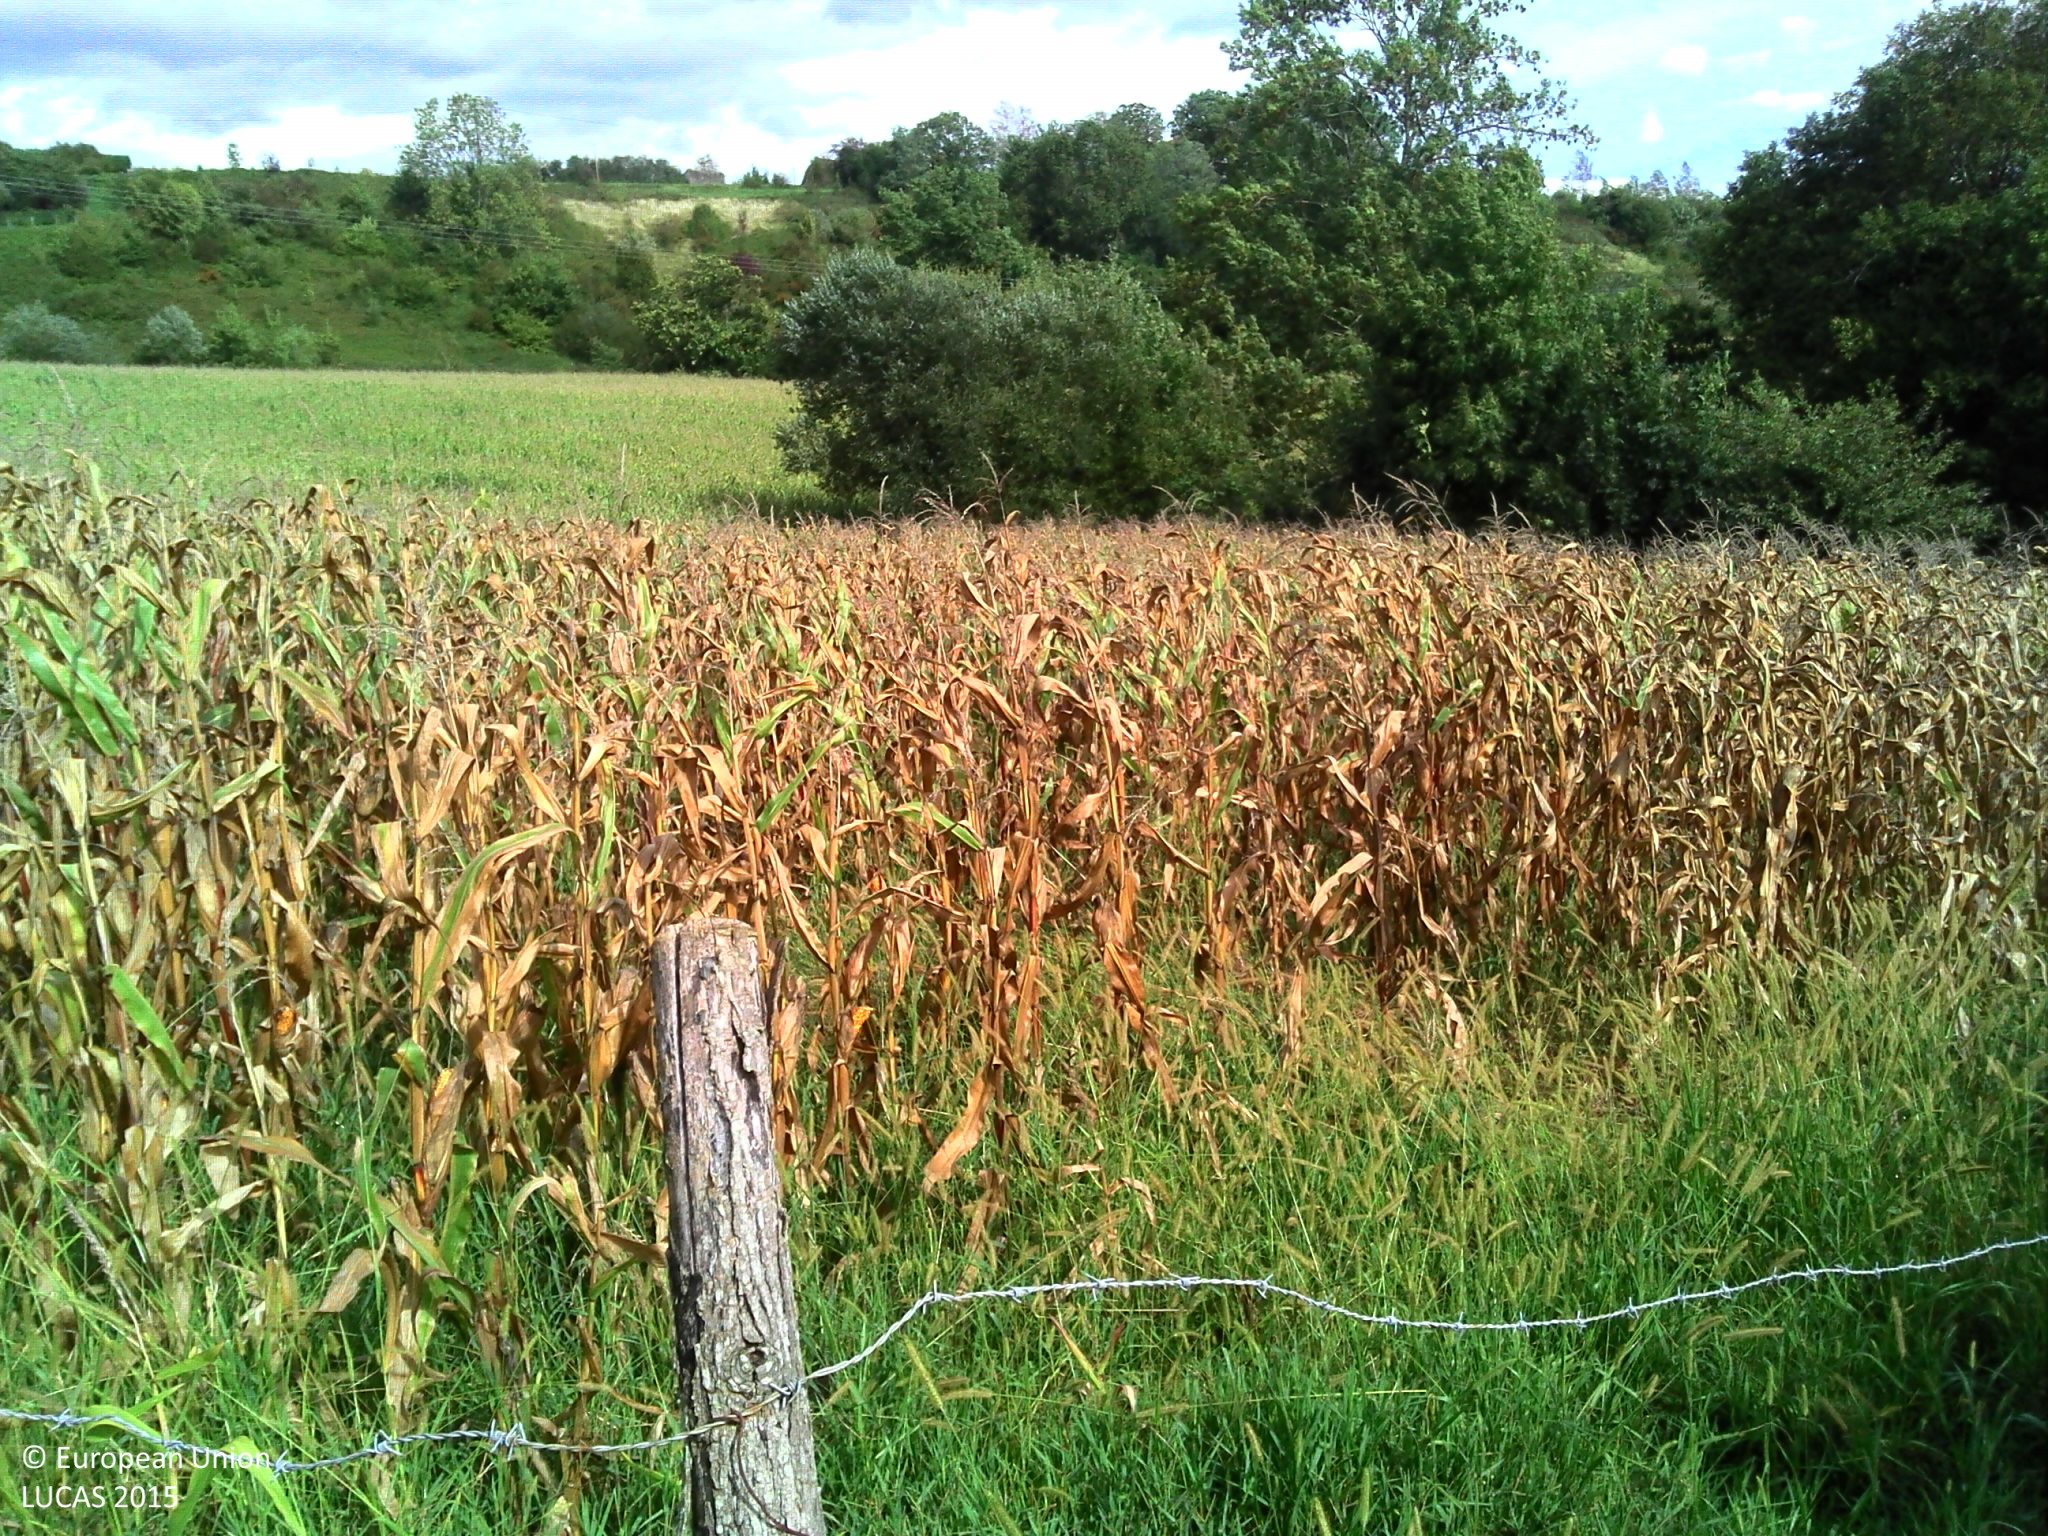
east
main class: Cropland
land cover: Maize
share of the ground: > 75 %
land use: Agriculture (excluding fallow land and kitchen gardens)
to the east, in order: Maize; Grass margins; Fences; Grass margins; Maize; Tracks; Broadleaved woodland; Maize; Electric lines; Maize; Grass margins; Broadleaved woodland; Grassland without tree/shrub cover
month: September
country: FR
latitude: 43.3993
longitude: -0.6654
